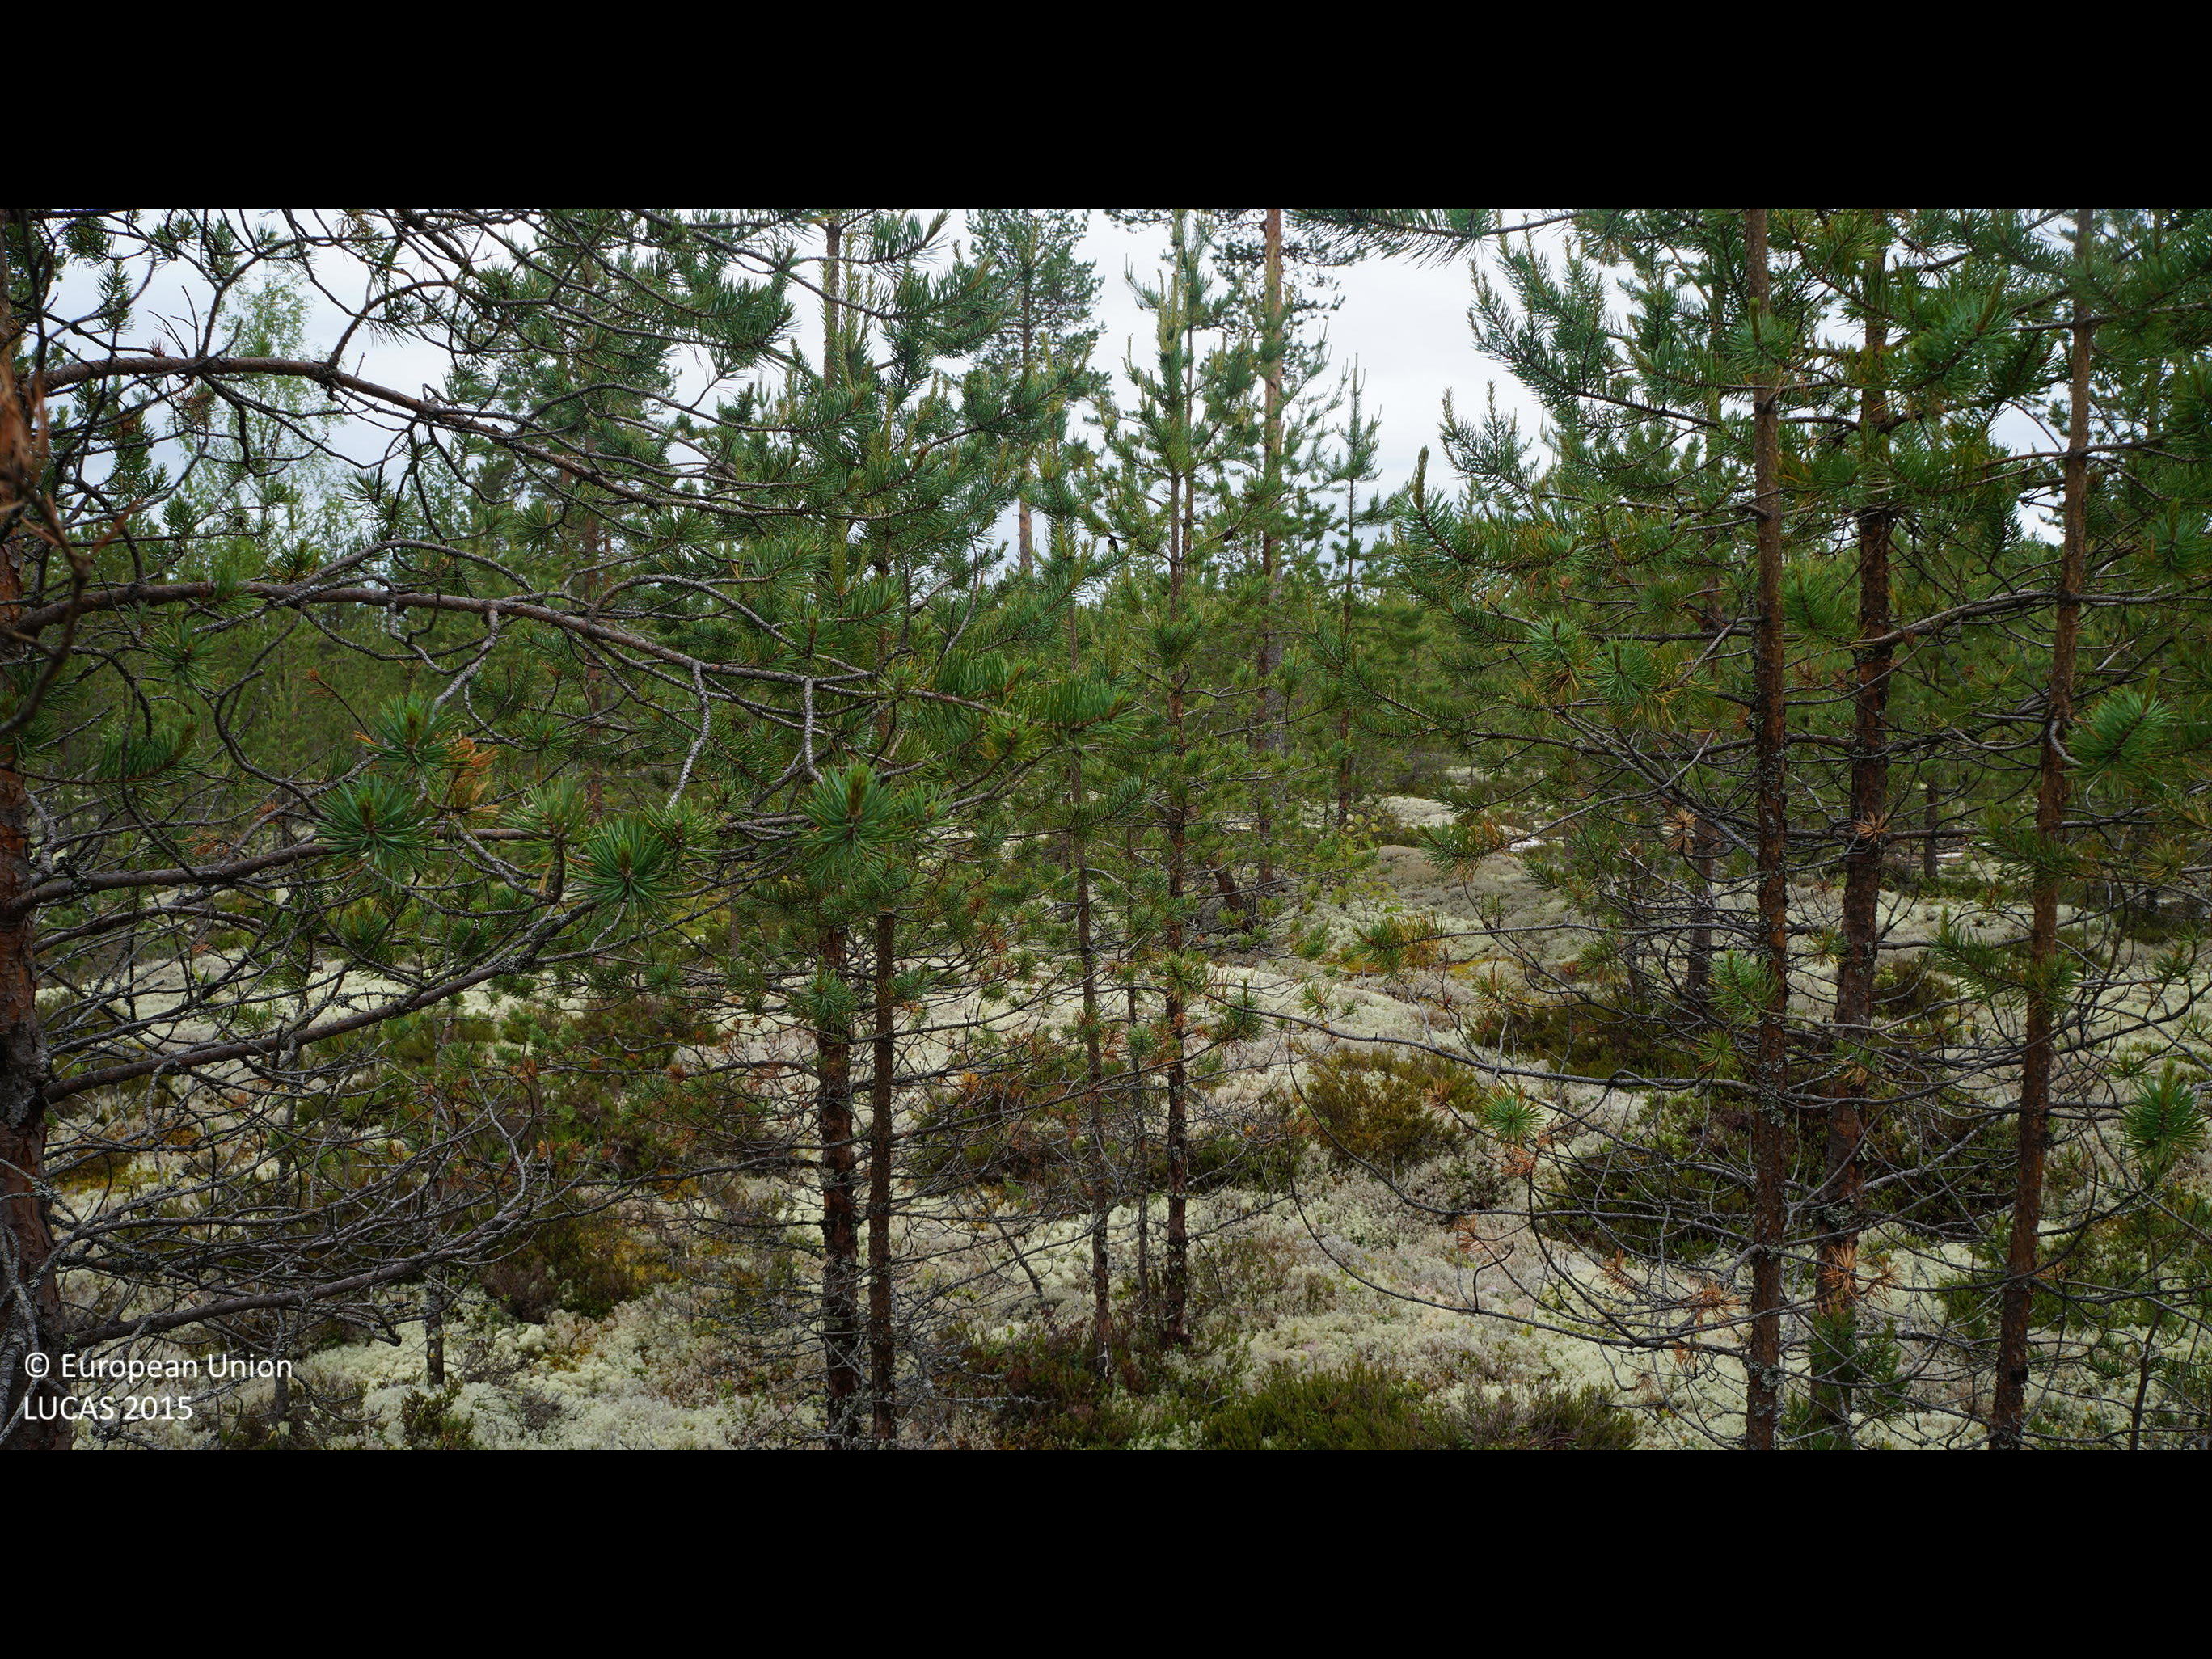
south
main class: Woodland
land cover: Pine dominated coniferous woodland
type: boreal forest
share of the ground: 25 - 50 %
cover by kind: coniferous forest trees 40 %, shrubs 30 %, lichens and mosses 25 %, broadleaved forest trees 5 %
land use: Forestry
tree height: > 5 m
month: June
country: FI
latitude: 64.3387
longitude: 24.6653
